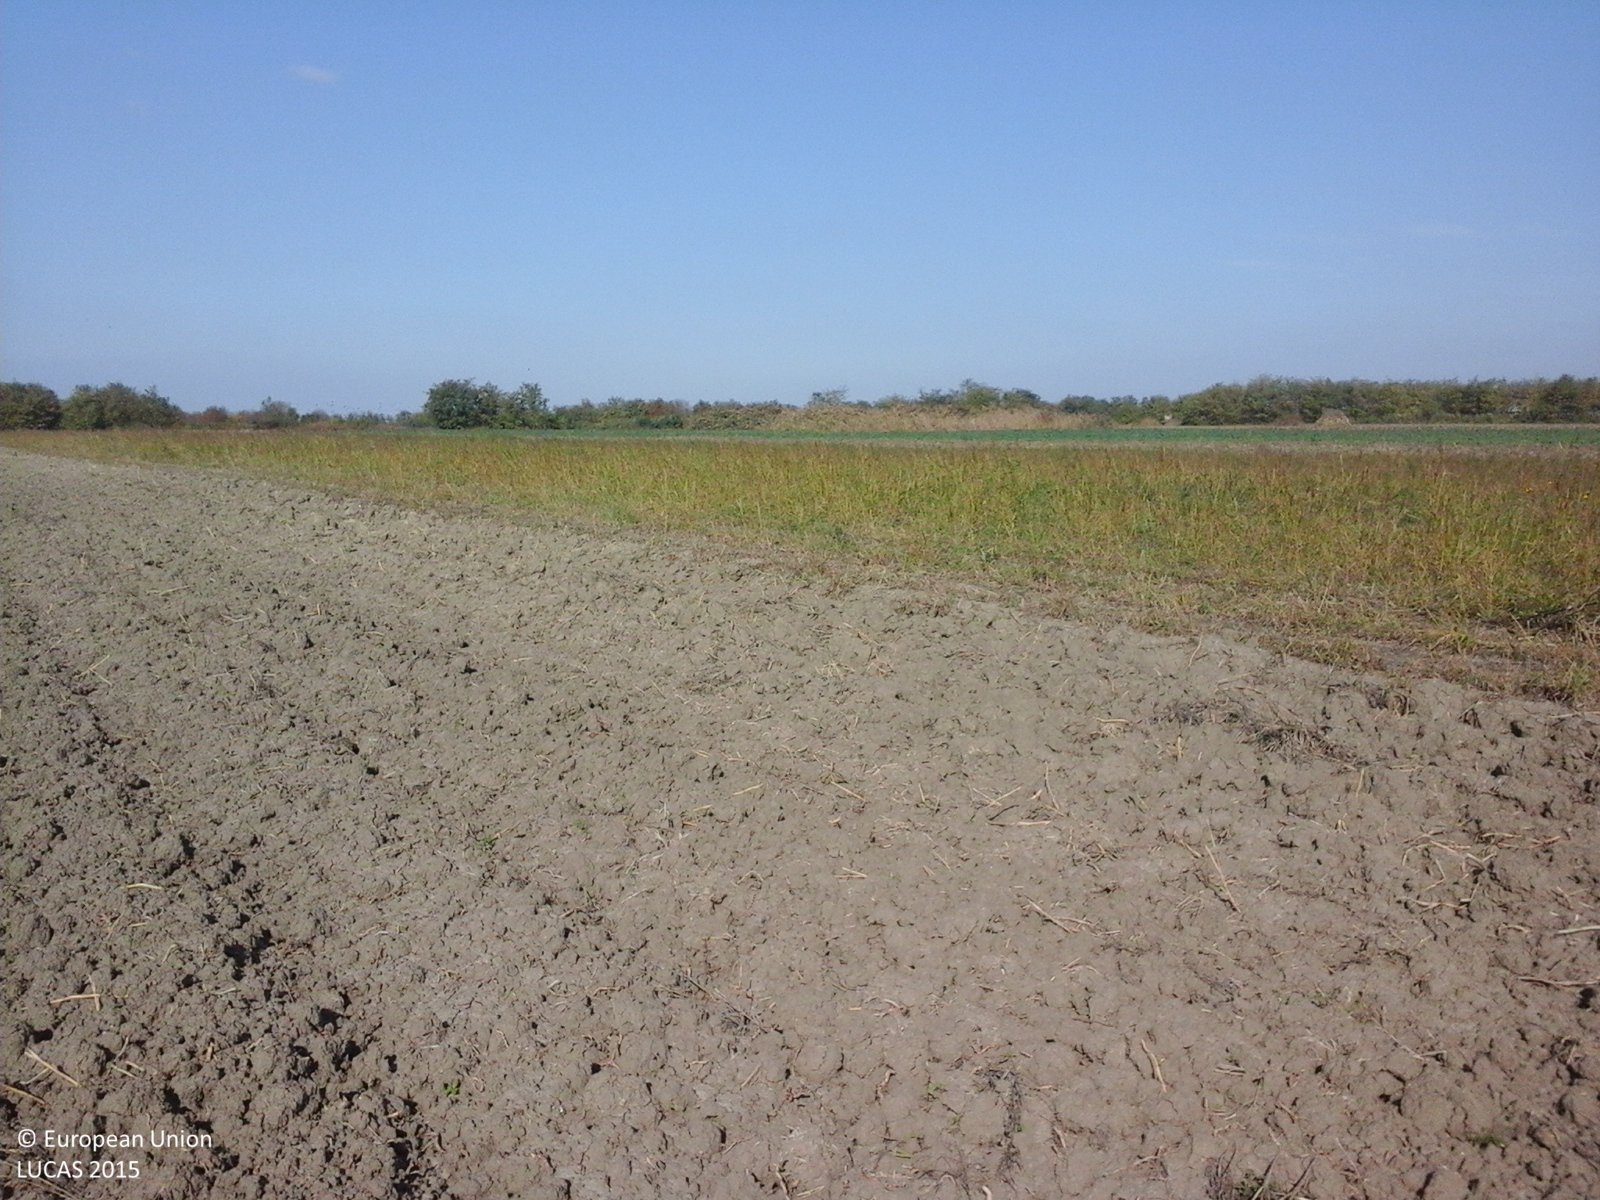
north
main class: Cropland
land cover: Maize
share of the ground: < 10 %
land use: Agriculture (excluding fallow land and kitchen gardens)
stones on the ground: < 10 %
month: October
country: RO
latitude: 45.4934
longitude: 27.4393
